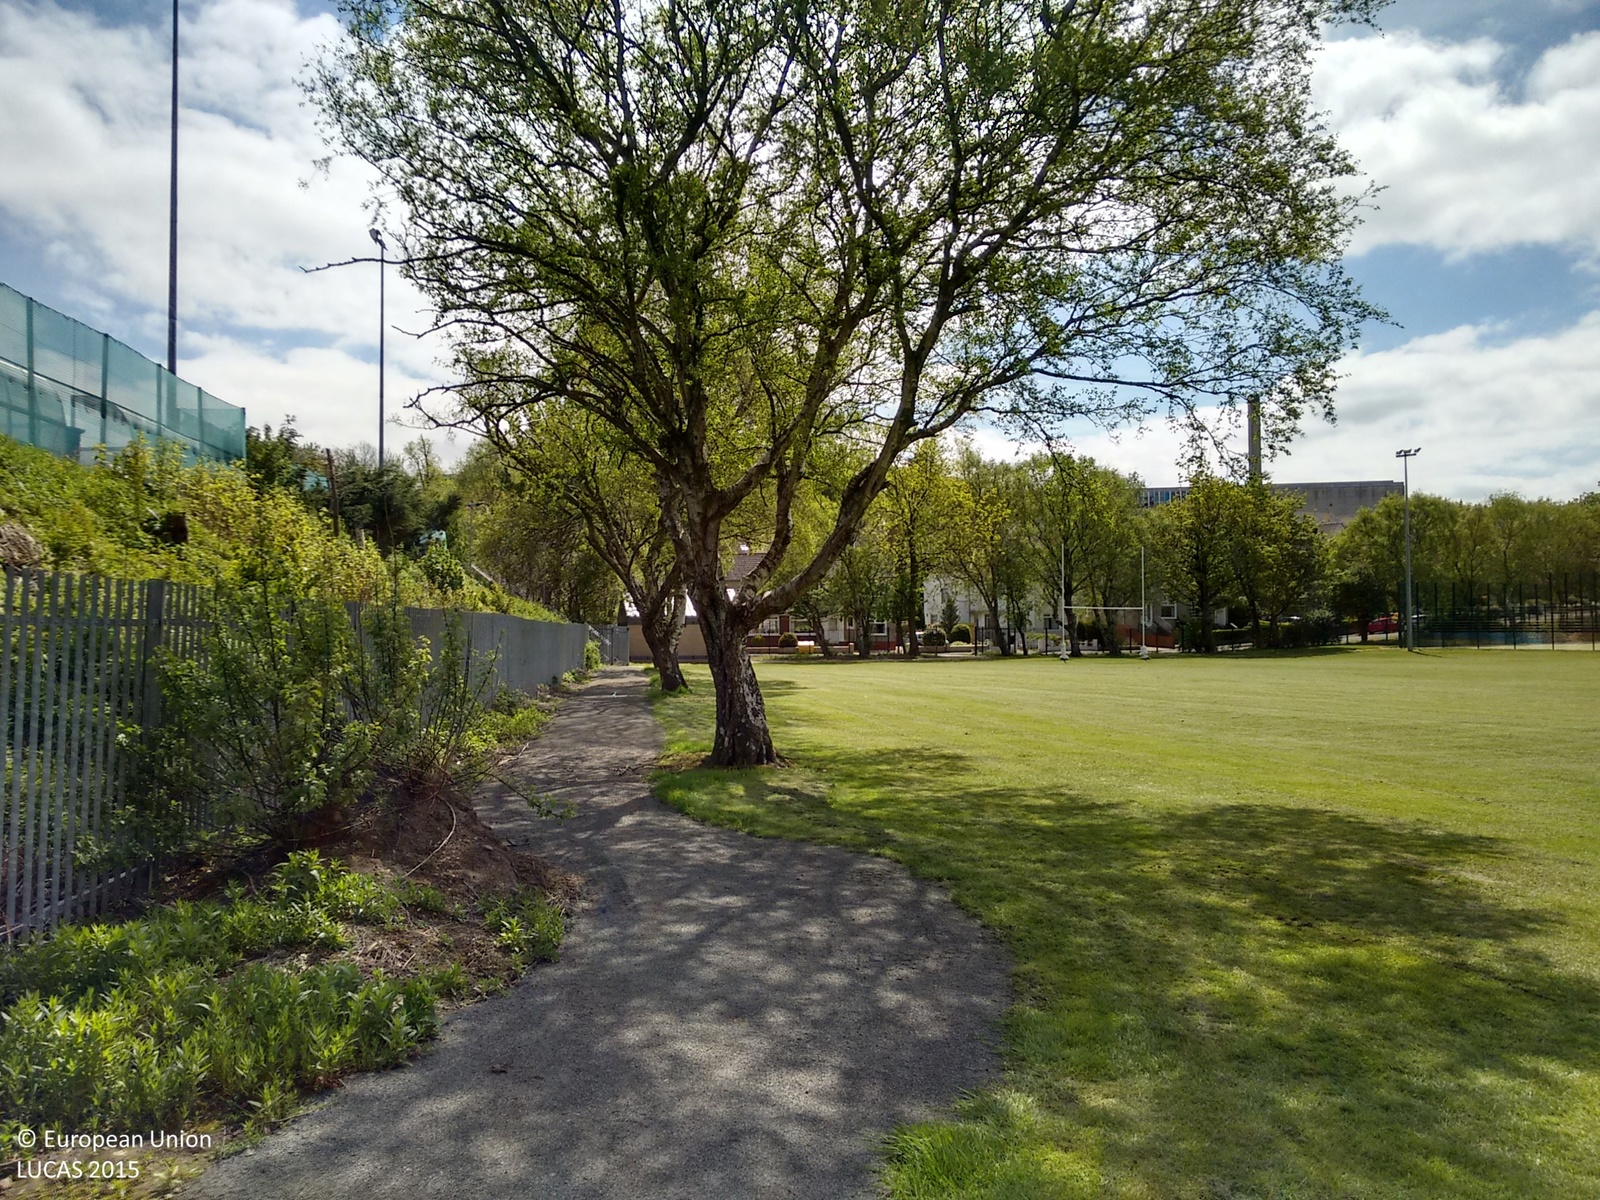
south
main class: Woodland
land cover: Broadleaved woodland
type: exotic forest
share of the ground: > 75 %
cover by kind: broadleaved forest trees 60 %, herbaceous plants 40 %
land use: Sport
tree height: > 5 m
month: May
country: GB
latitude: 55.8886
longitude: -4.3410
